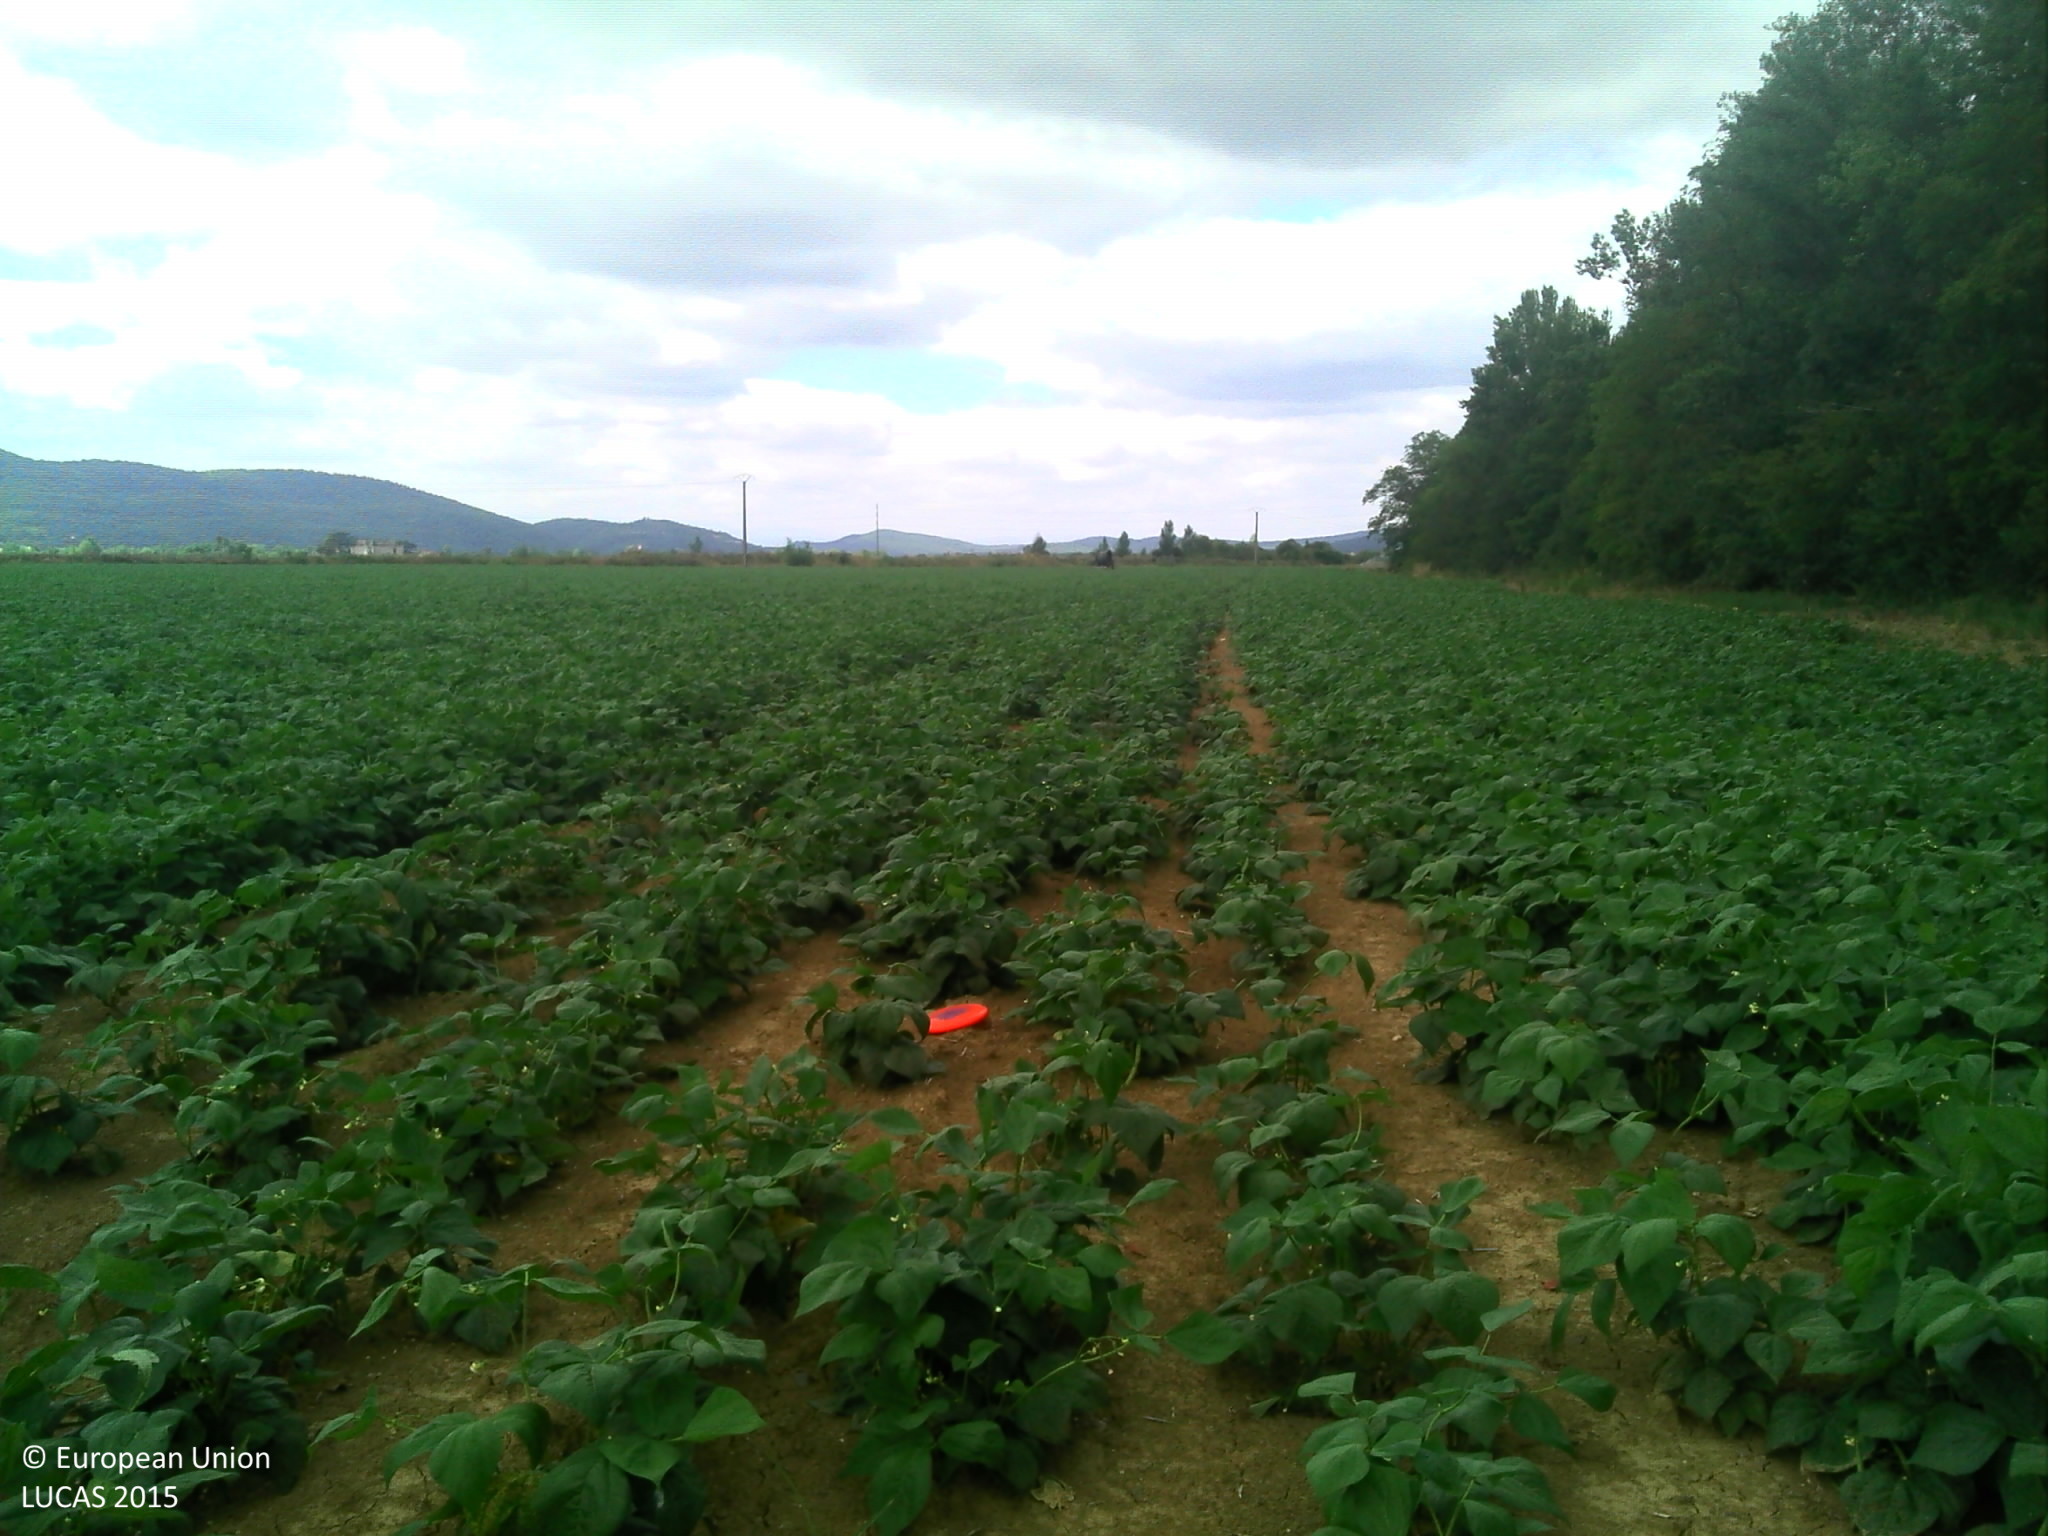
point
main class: Cropland
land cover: Other fresh vegetables
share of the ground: > 75 %
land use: Agriculture (excluding fallow land and kitchen gardens)
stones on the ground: < 10 %
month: July
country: FR
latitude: 43.2196
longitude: 1.0531
